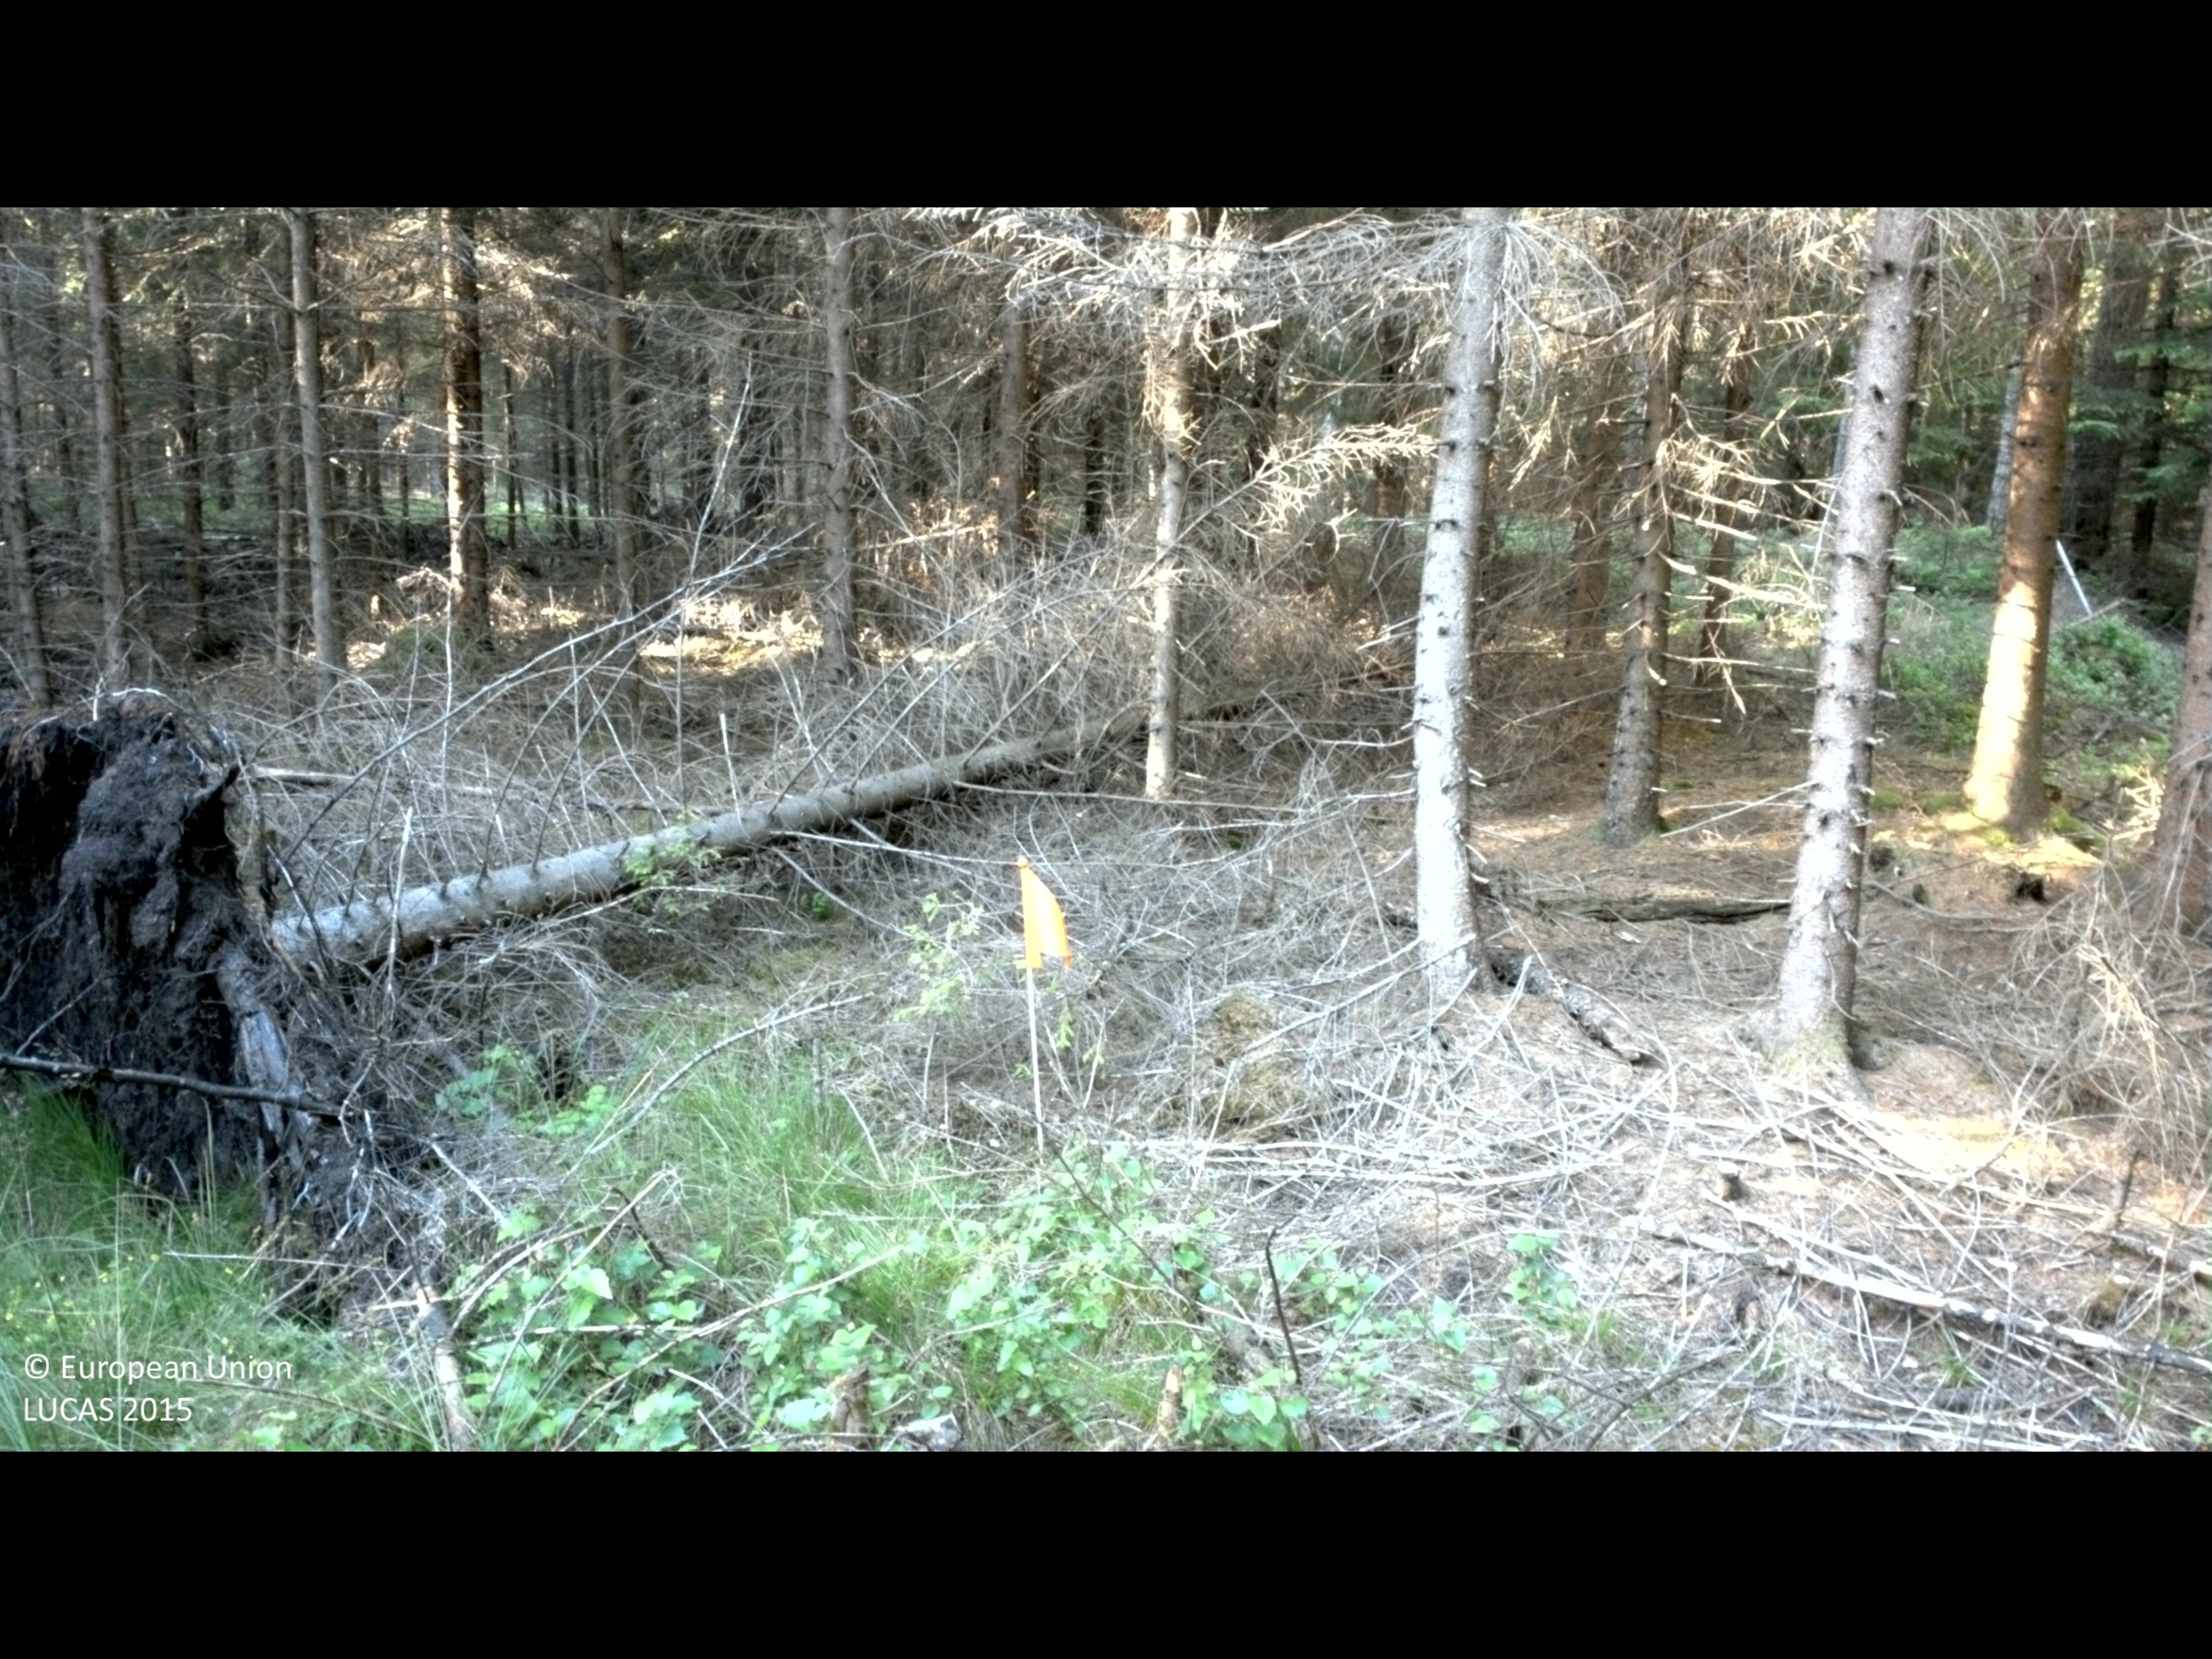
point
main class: Woodland
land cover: Spruce dominated coniferous woodland
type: boreal forest
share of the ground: > 75 %
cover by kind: coniferous forest trees 75 %, herbaceous plants 10 %, broadleaved forest trees 5 %, shrubs 5 %, lichens and mosses 5 %
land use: Forestry
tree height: > 5 m
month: July
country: SE
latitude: 56.4970
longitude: 14.2045
